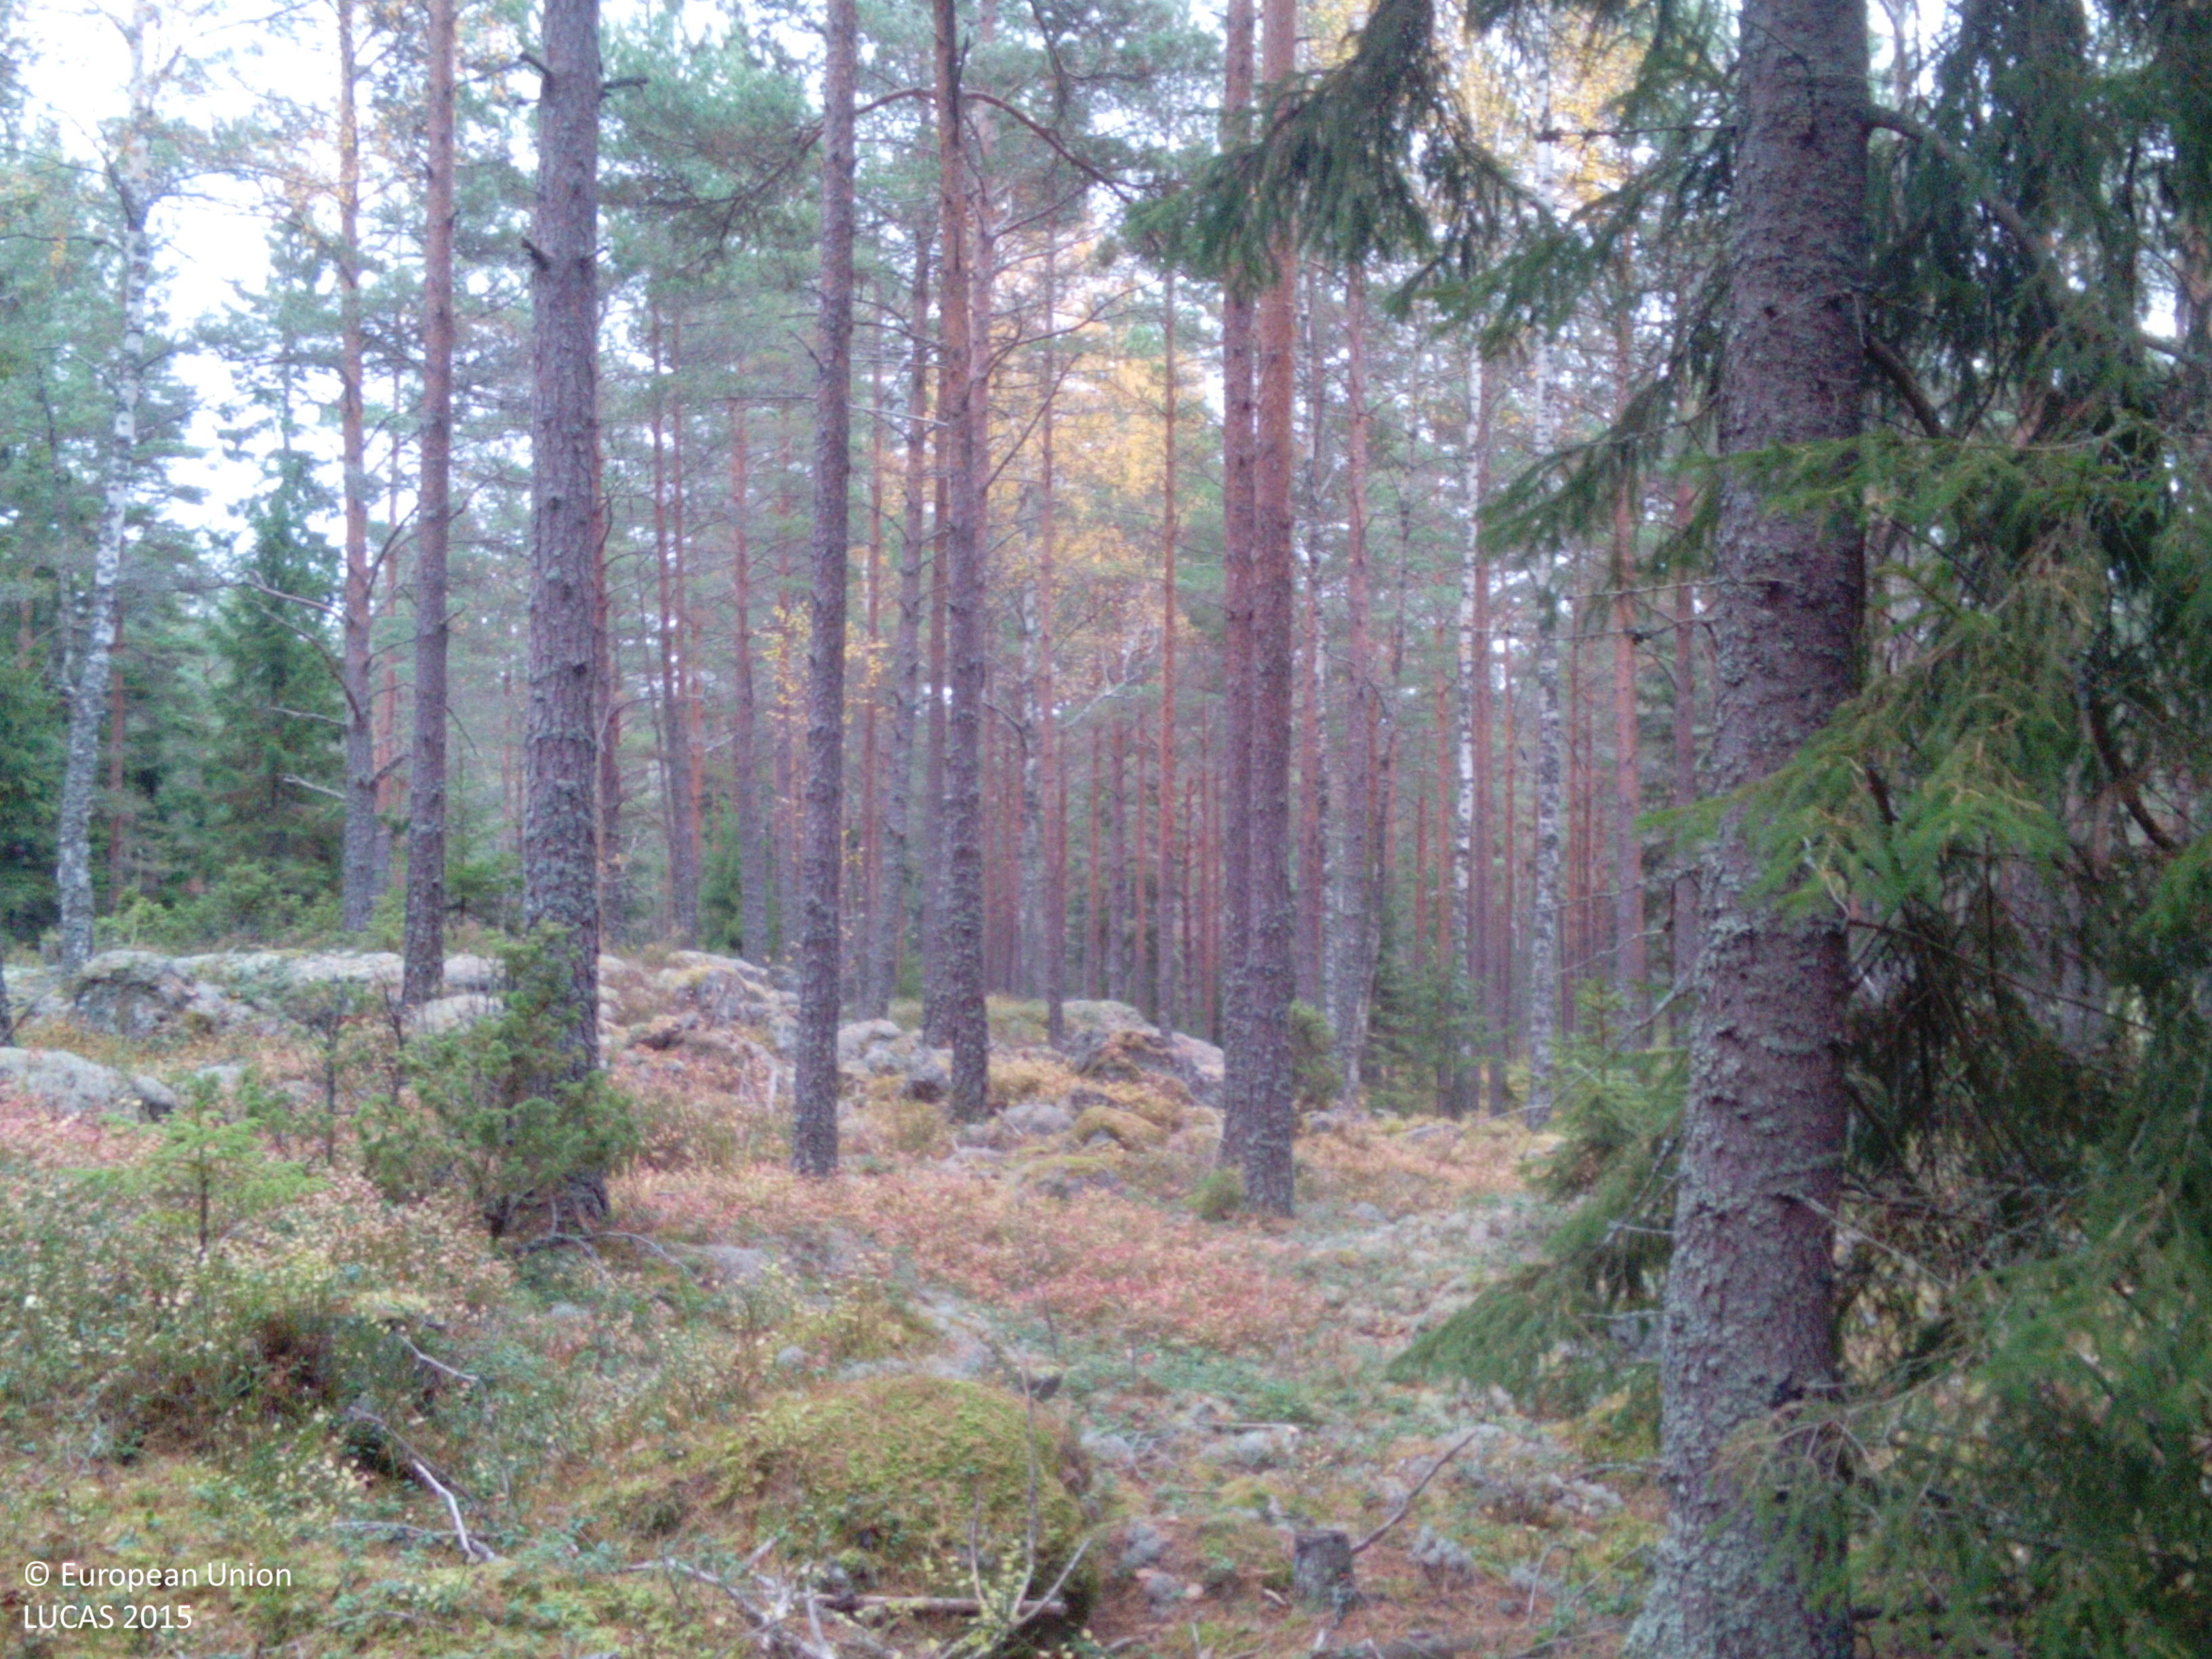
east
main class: Woodland
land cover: Pine dominated coniferous woodland
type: boreal forest
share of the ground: > 75 %
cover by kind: coniferous forest trees 75 %, broadleaved forest trees 10 %, herbaceous plants 10 %, lichens and mosses 5 %
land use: Forestry
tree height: > 5 m
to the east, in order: Pine dominated coniferous woodland; Pine dominated mixed woodland; Other coniferous woodland; Tracks; Spruce dominated mixed woodland; Pine dominated coniferous woodland; Other coniferous woodland; Rivers and streams; Spruce dominated coniferous woodland
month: October
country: SE
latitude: 59.2068
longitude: 16.3504
